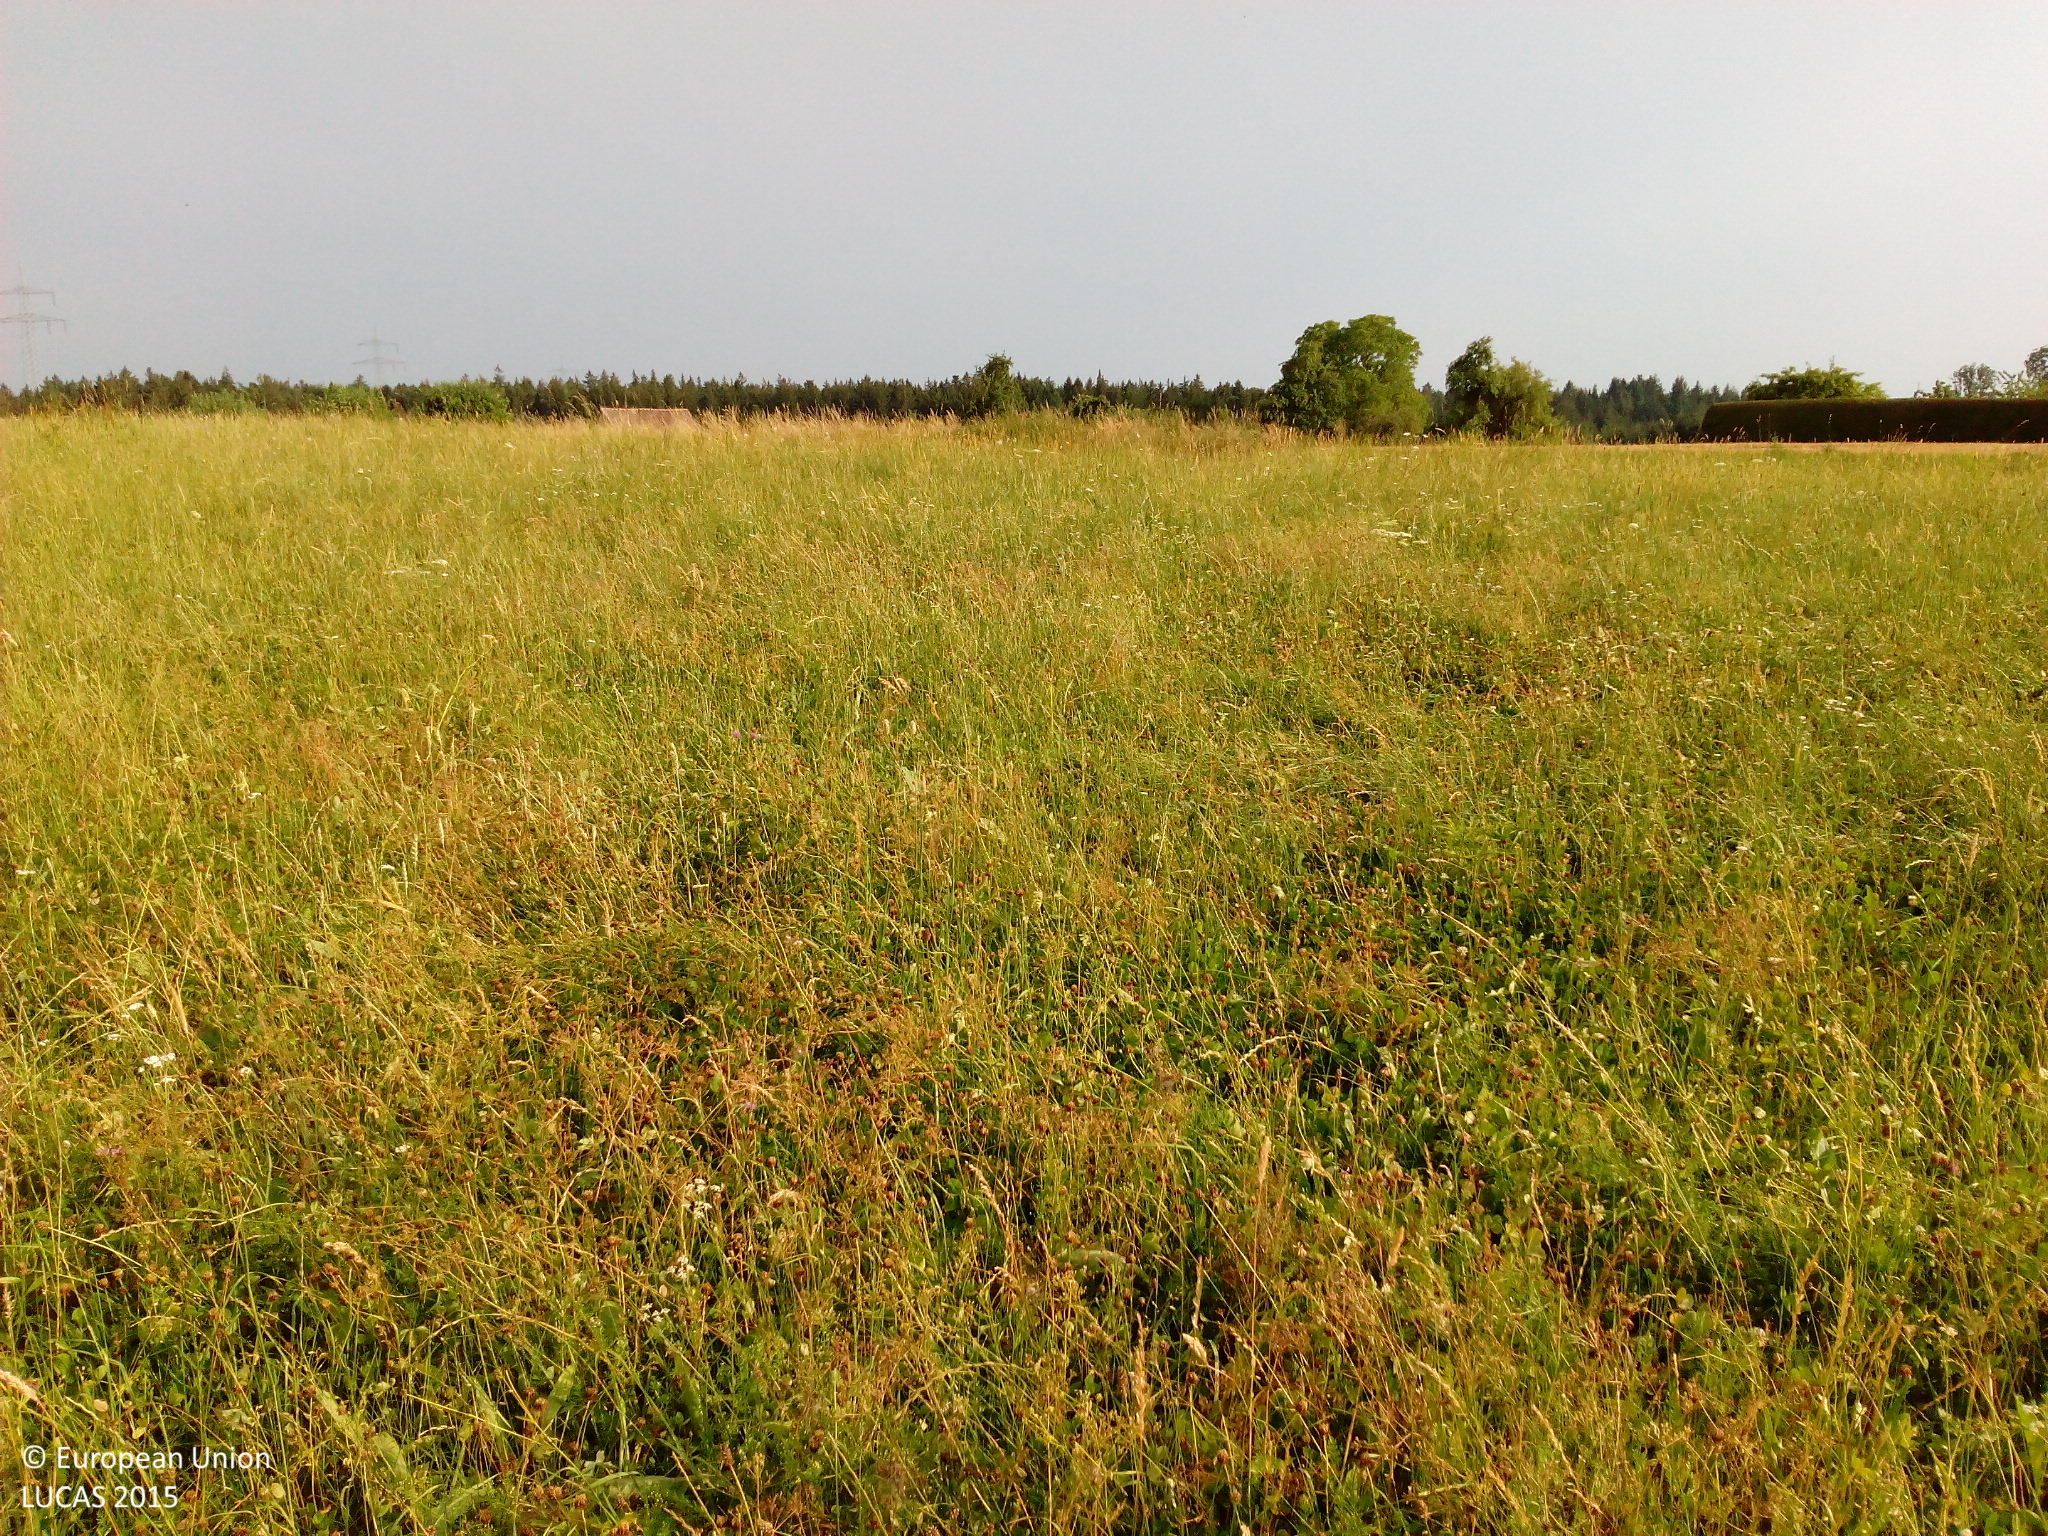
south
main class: Cropland
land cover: Common wheat
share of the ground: > 75 %
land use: Agriculture (excluding fallow land and kitchen gardens)
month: July
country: DE
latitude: 49.0332
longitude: 9.9590
